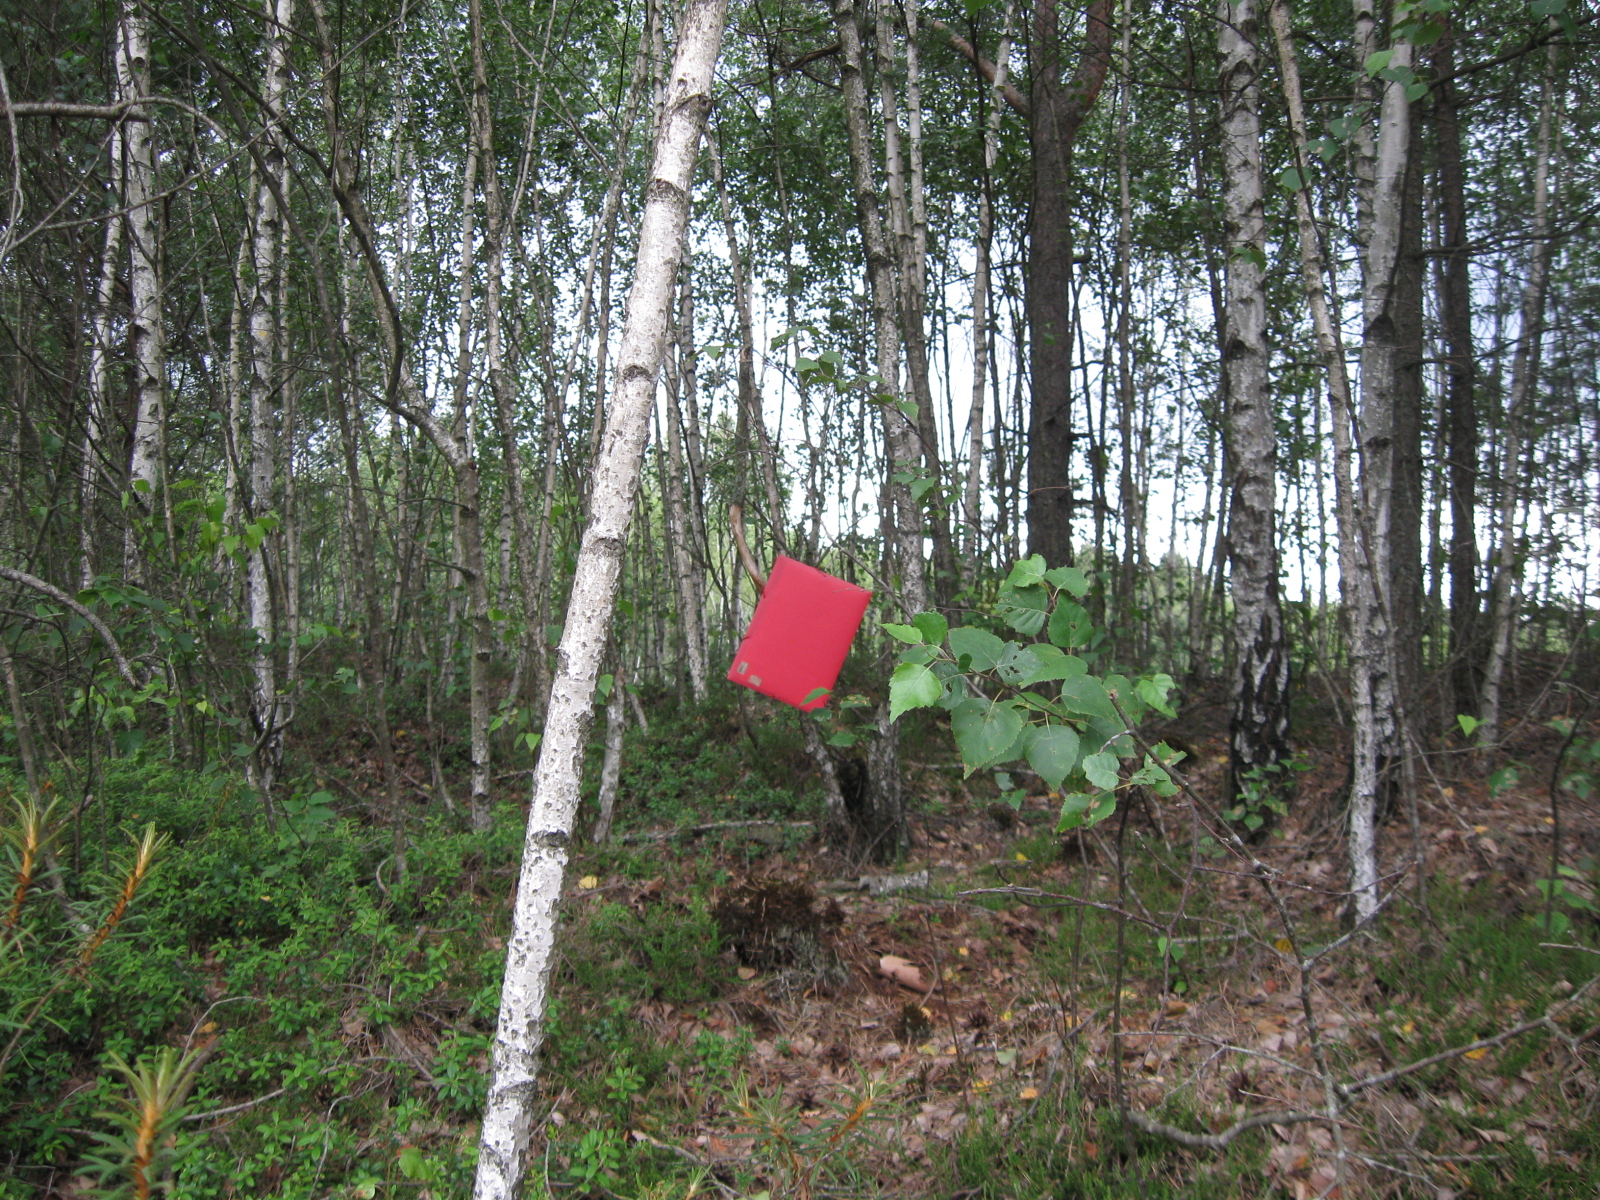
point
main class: Woodland
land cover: Pine dominated mixed woodland
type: mire and swamp forests
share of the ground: > 75 %
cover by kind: broadleaved forest trees 55 %, coniferous forest trees 25 %, herbaceous plants 15 %, shrubs 5 %
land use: Forestry
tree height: > 5 m
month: July
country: LT
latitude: 54.8754
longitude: 23.5947
